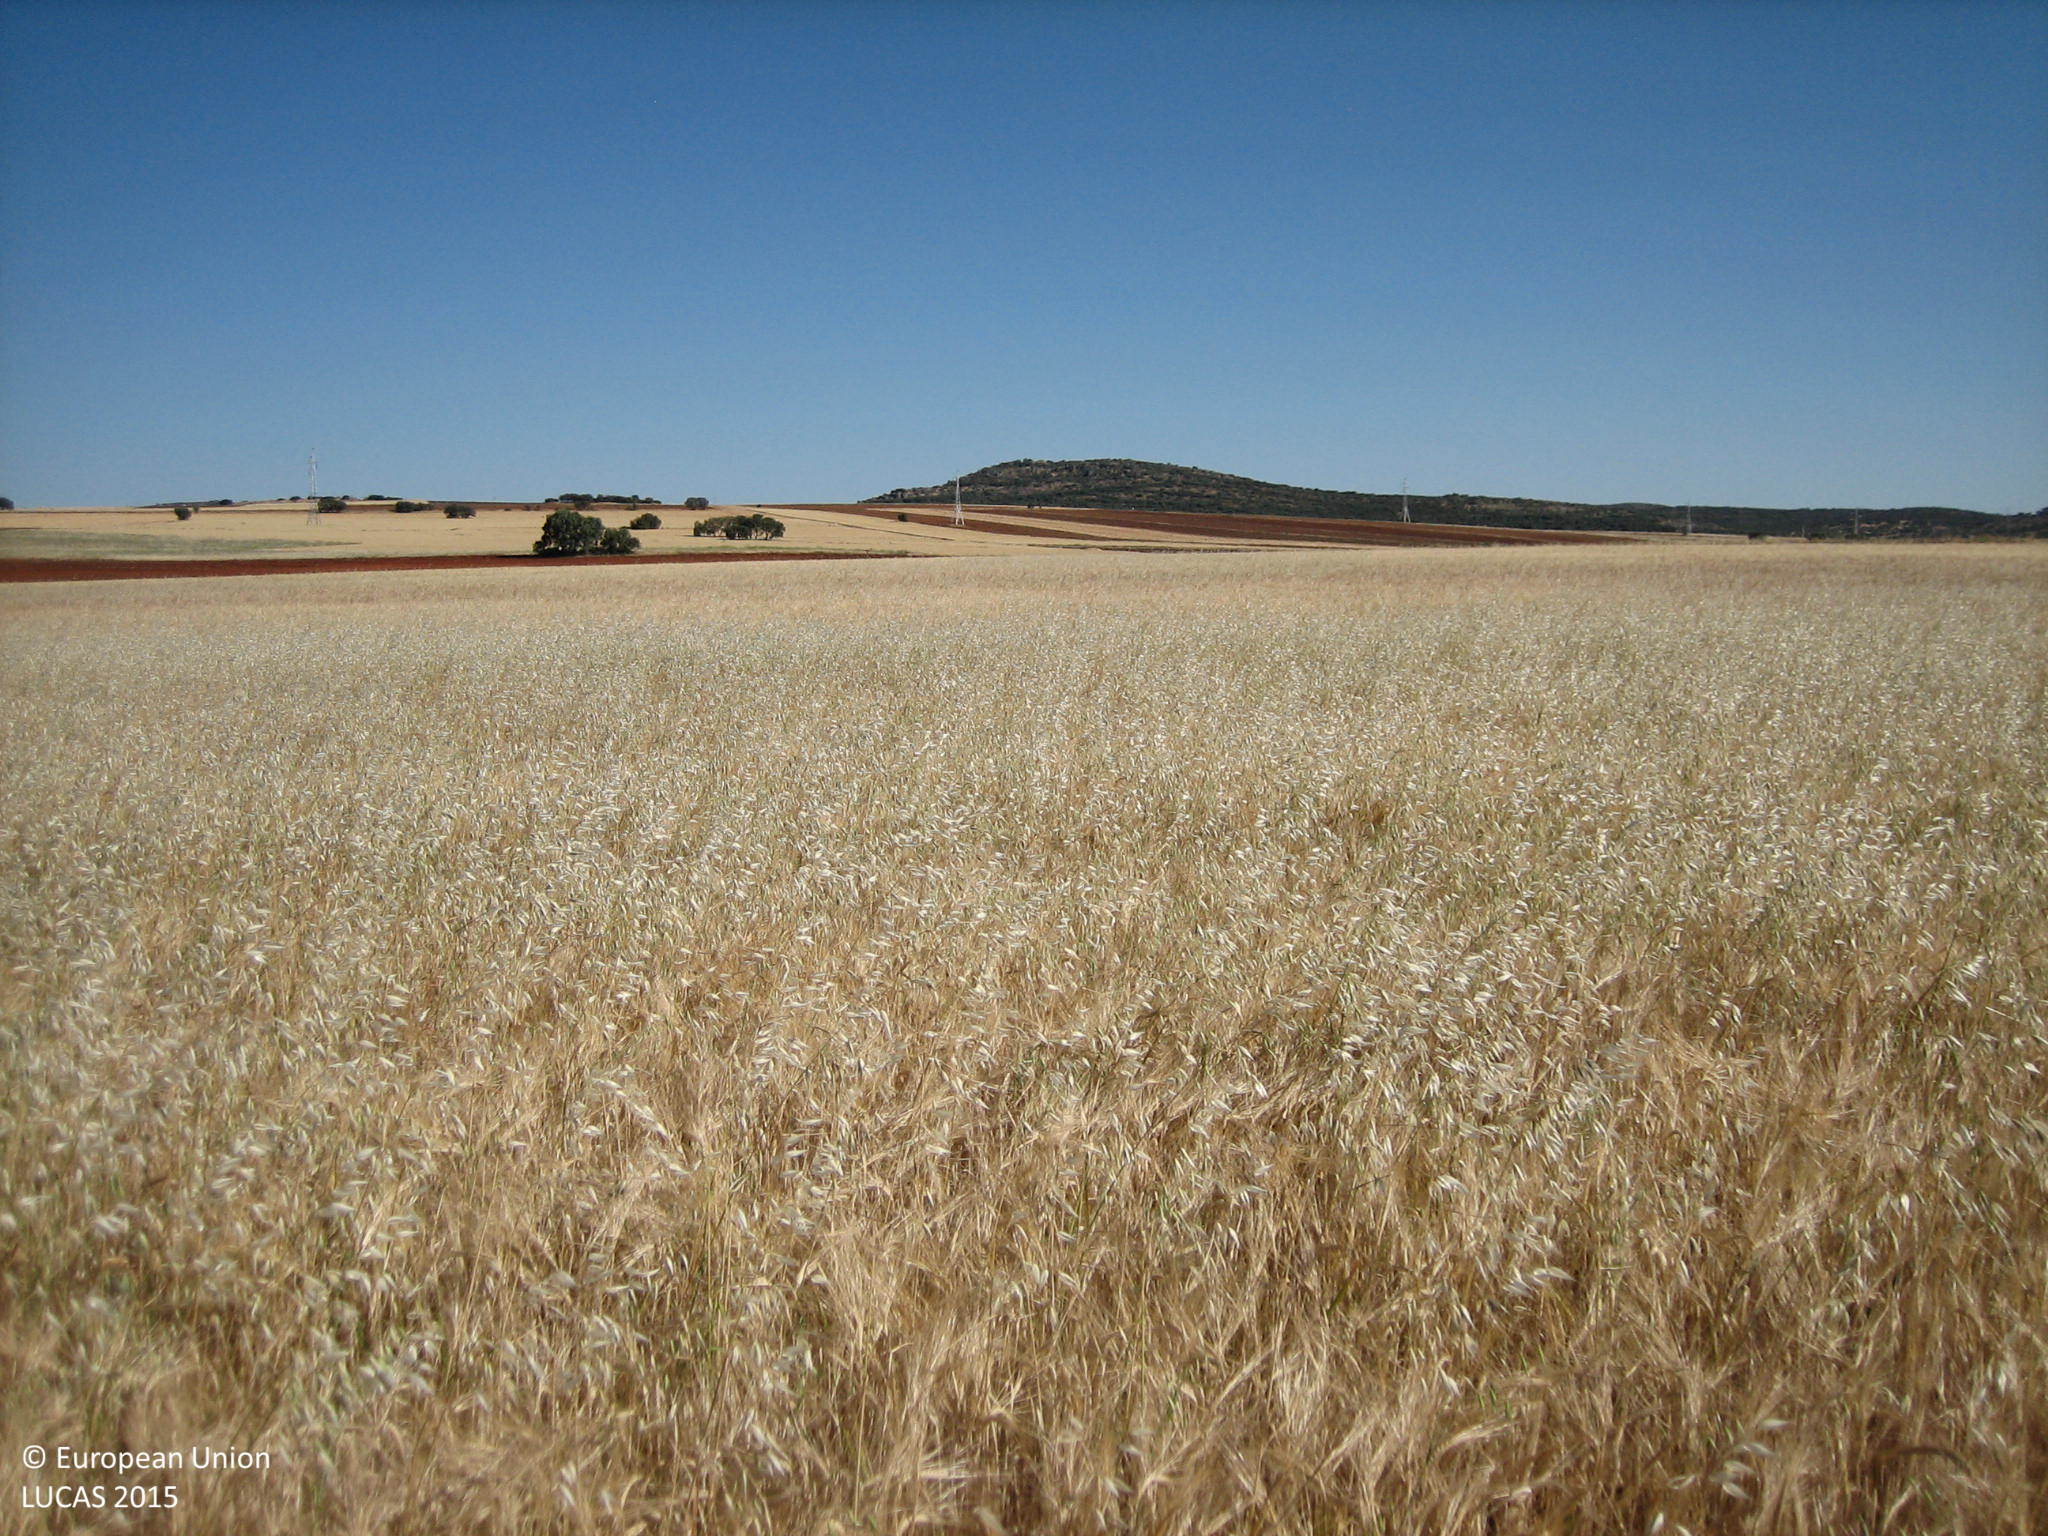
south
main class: Cropland
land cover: Barley
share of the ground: > 75 %
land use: Agriculture (excluding fallow land and kitchen gardens)
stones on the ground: < 10 %
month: June
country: ES
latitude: 38.8661
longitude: -4.0461
